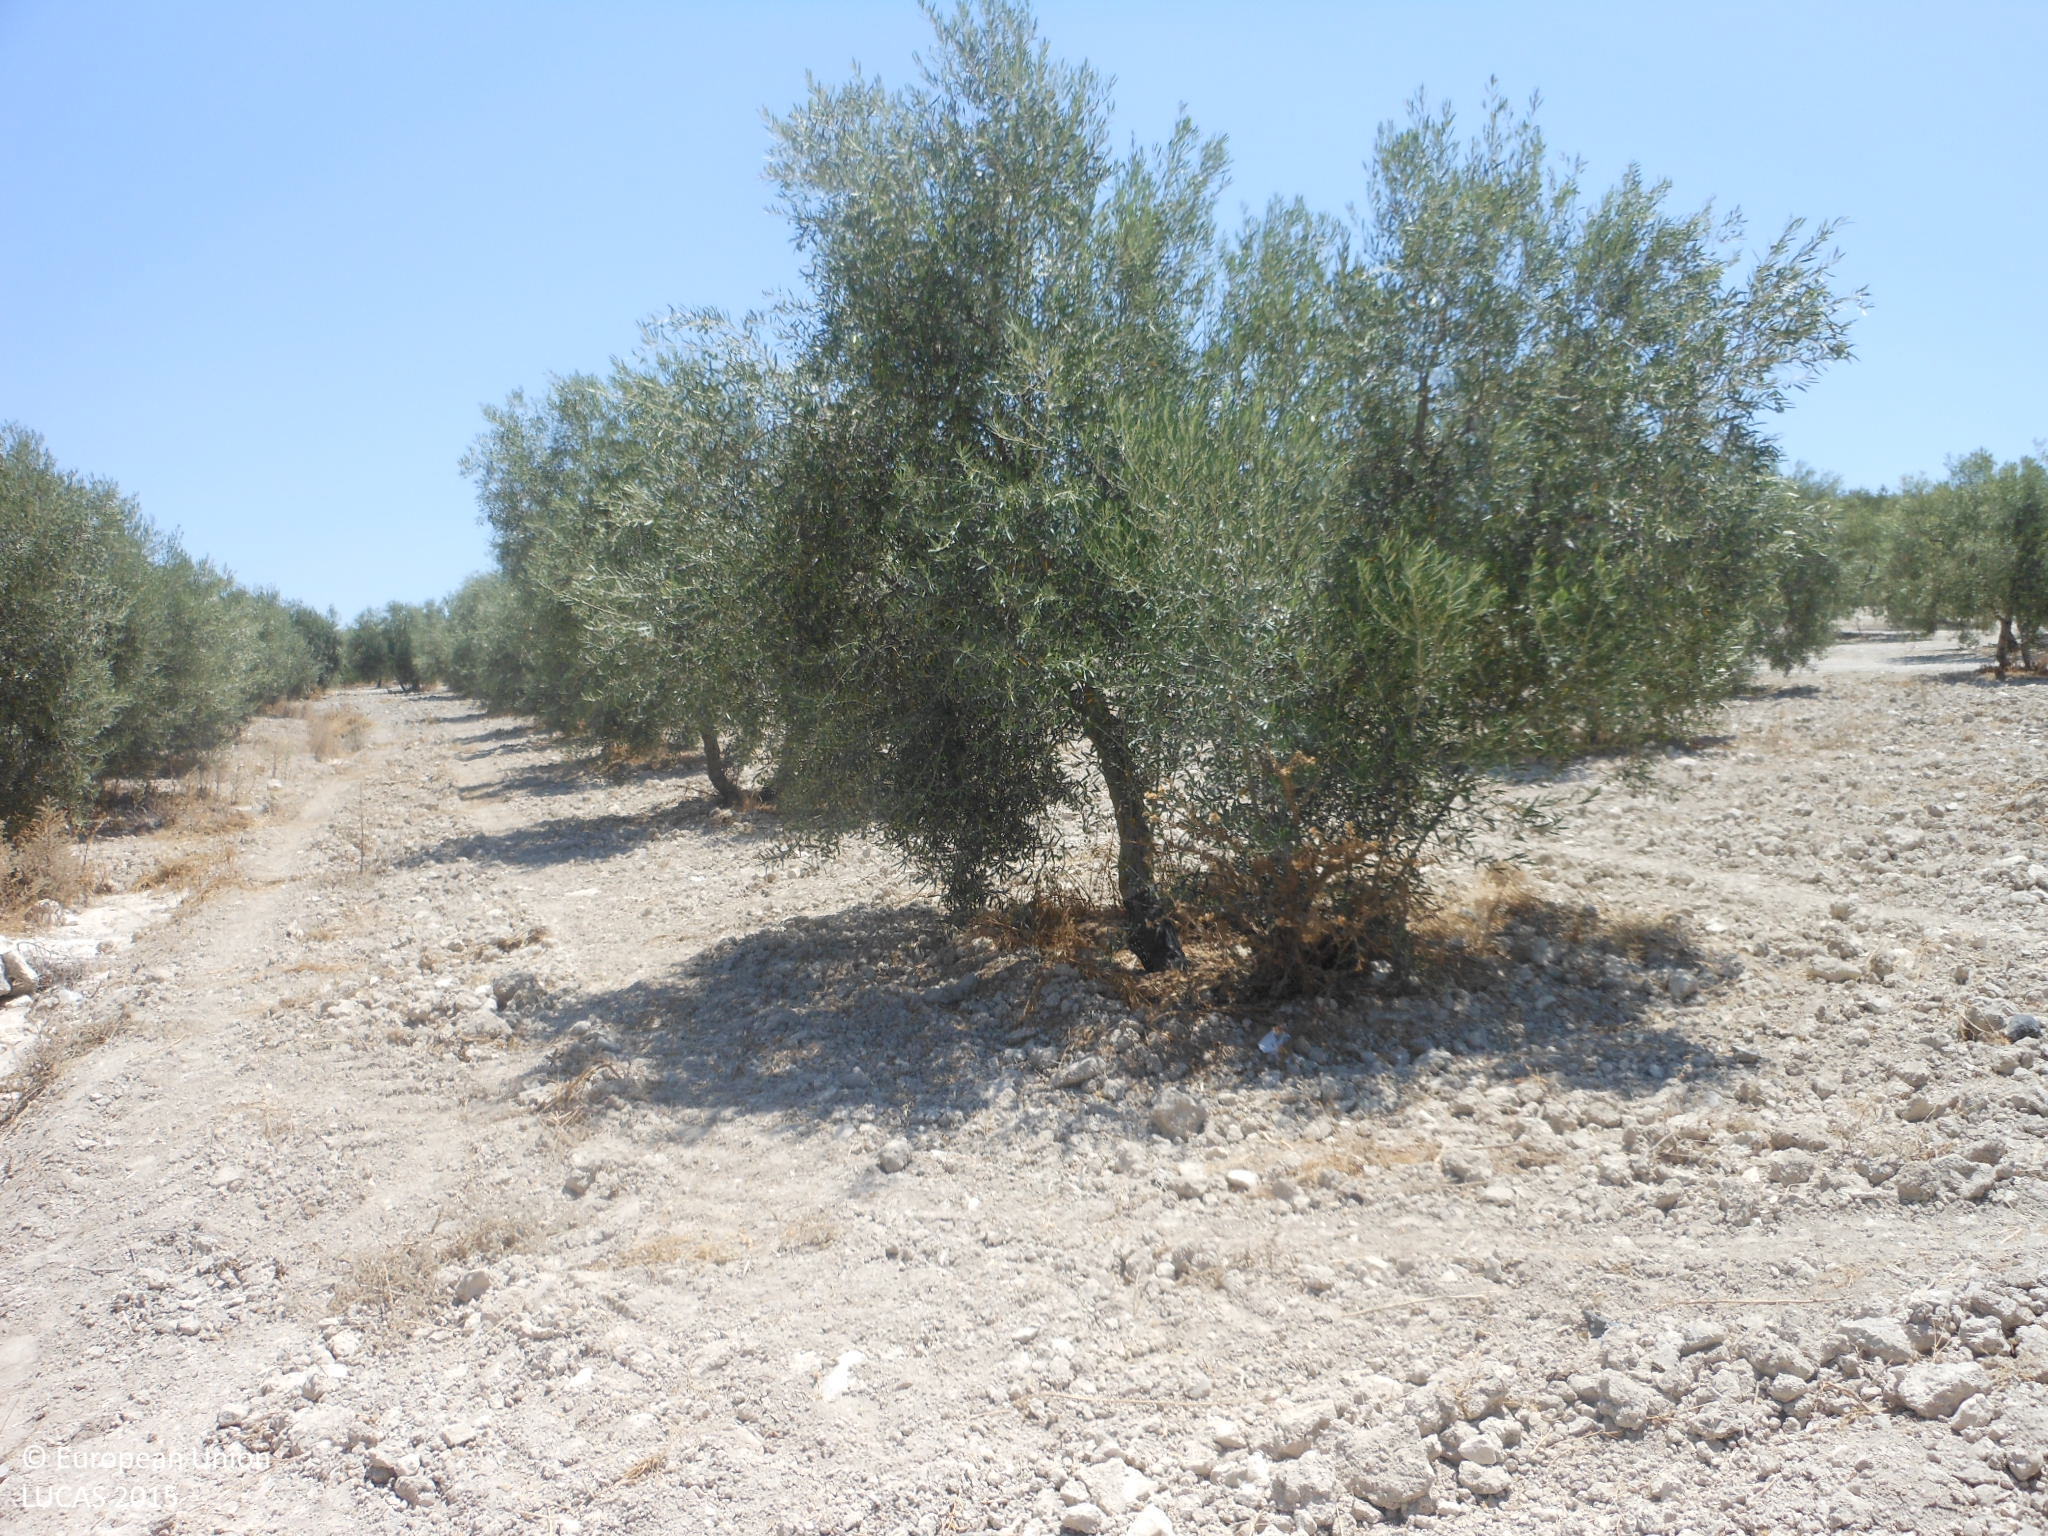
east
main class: Cropland
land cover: Olive groves
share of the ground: 25 - 50 %
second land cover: Other bare soil
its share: > 75 %
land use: Agriculture (excluding fallow land and kitchen gardens)
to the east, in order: Olive groves; Other bare soil; Grass margins; Olive groves; Grass margins; Olive groves
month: June
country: ES
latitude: 37.3047
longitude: -4.8871
